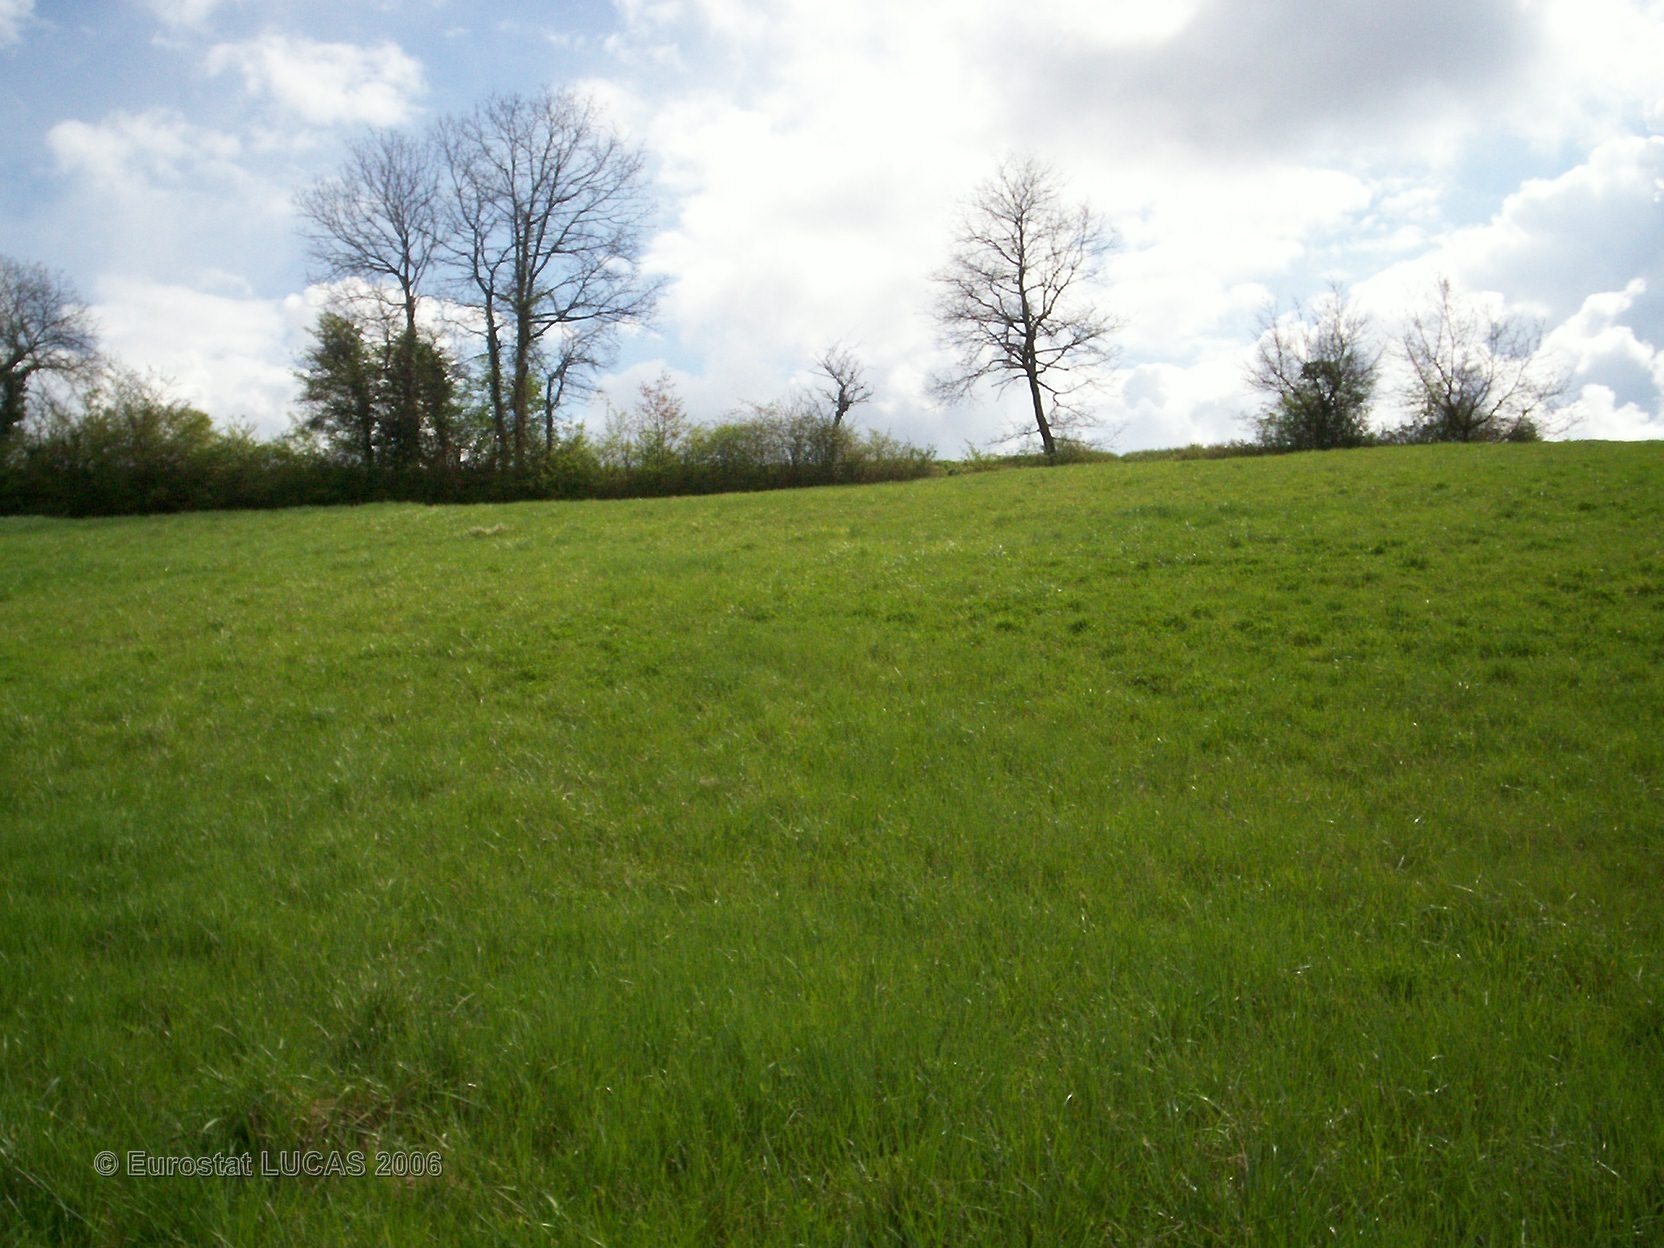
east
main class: Grassland
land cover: Grassland without tree/shrub cover
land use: Agriculture (excluding fallow land and kitchen gardens)
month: April
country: FR
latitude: 43.9701
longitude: 0.1332
